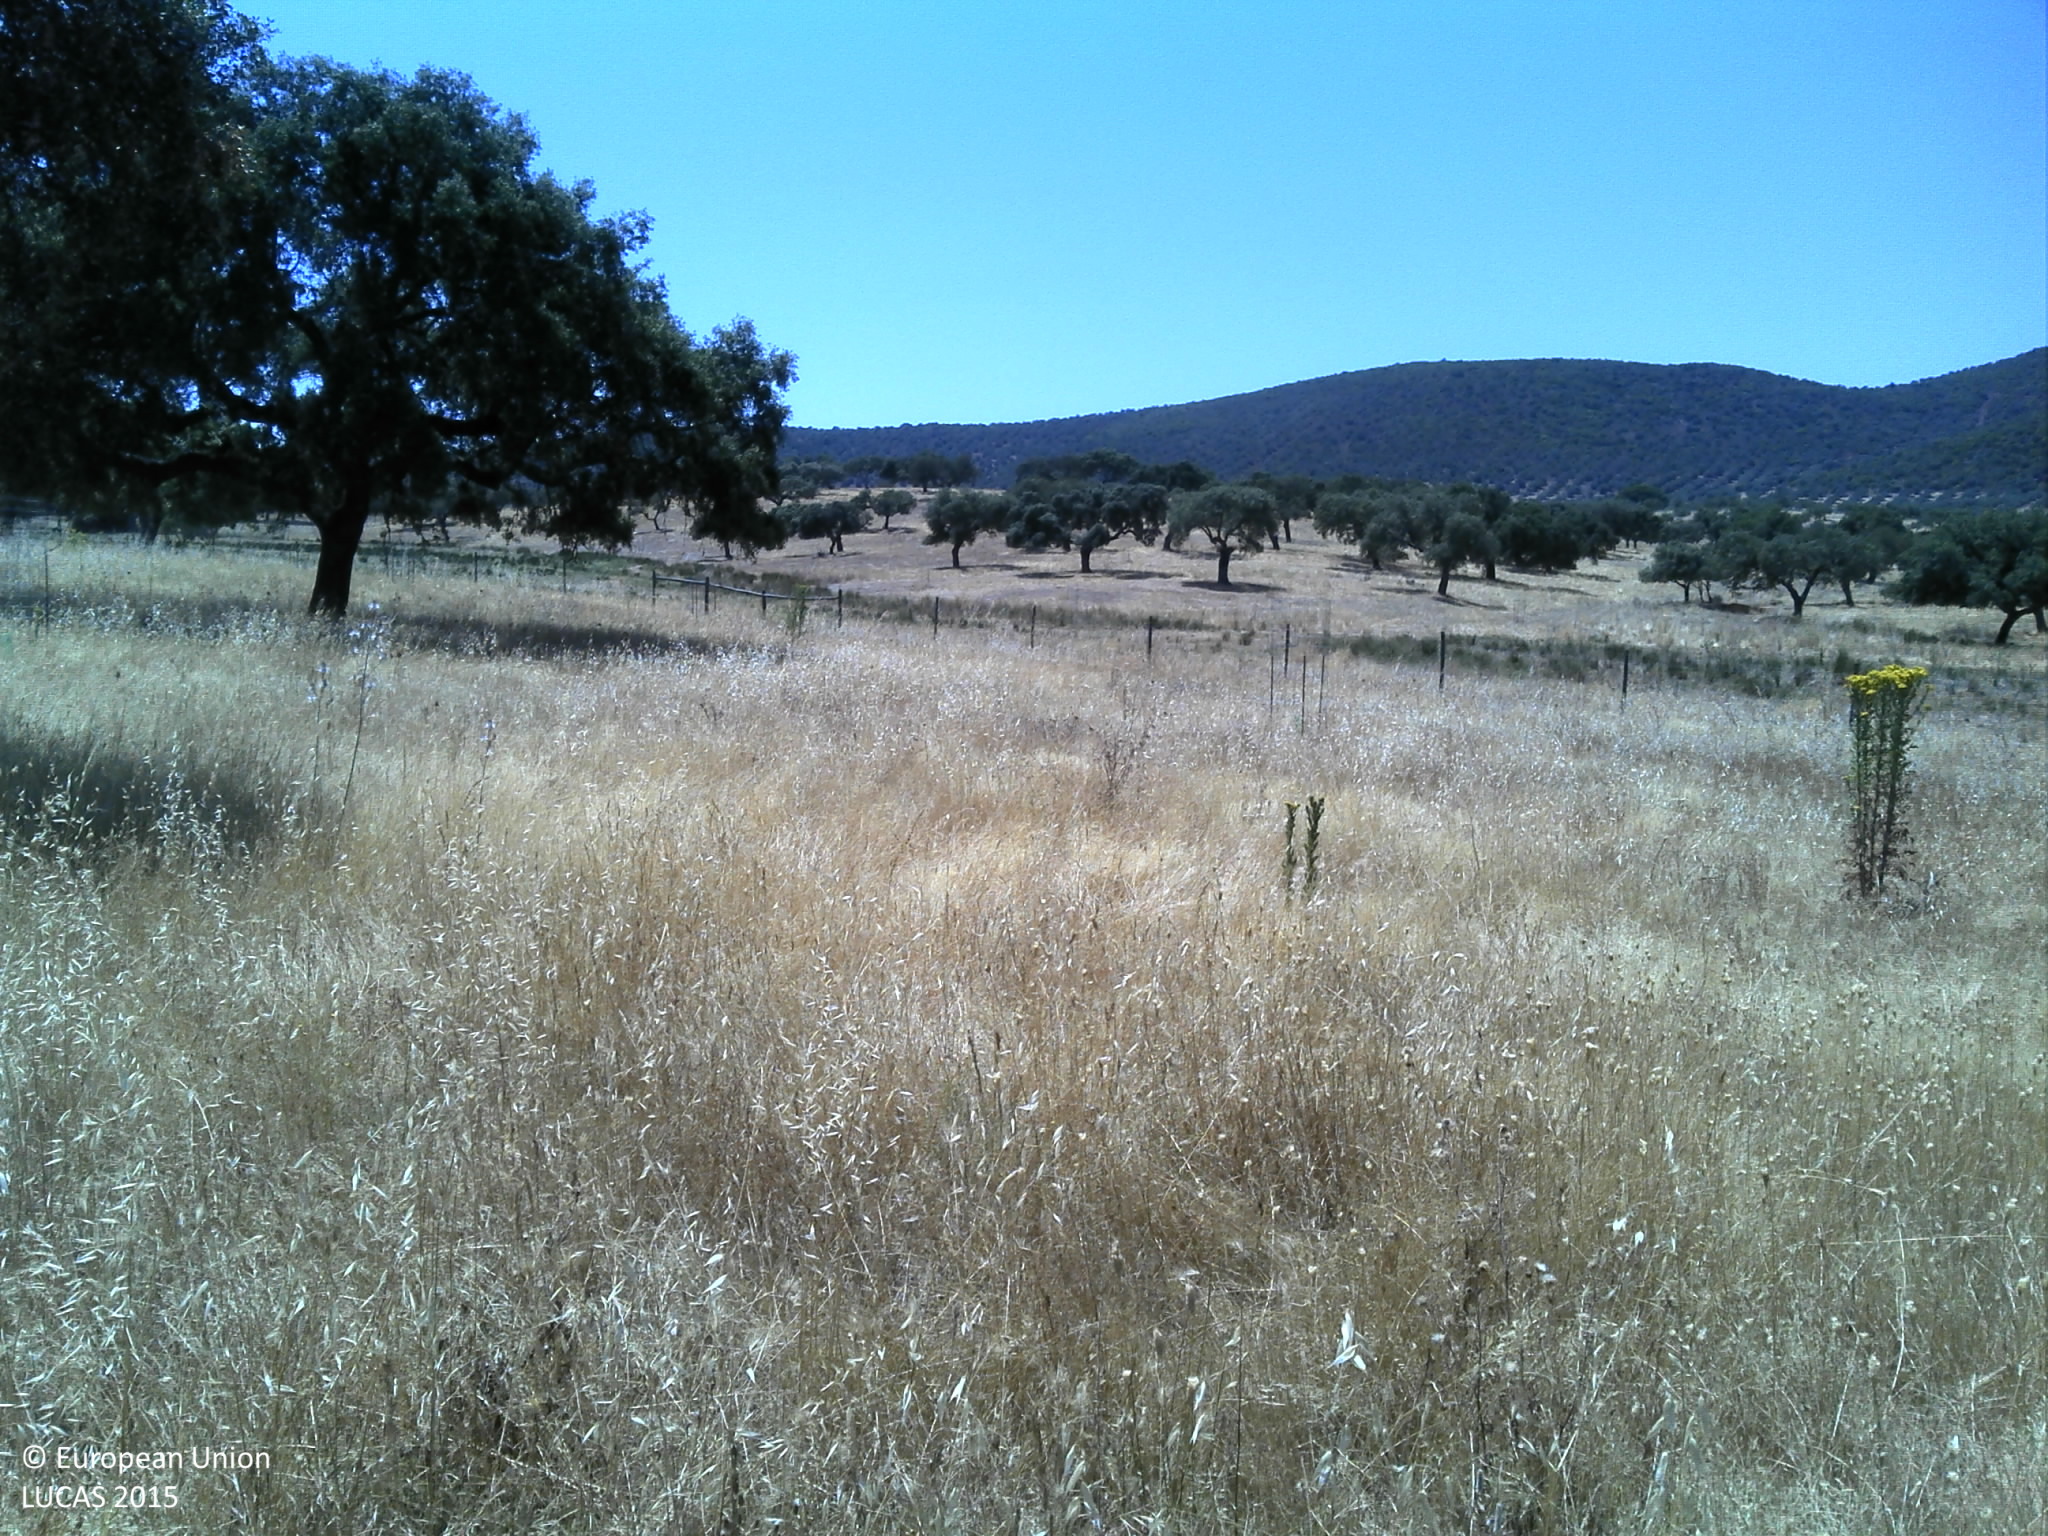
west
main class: Woodland
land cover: Broadleaved woodland
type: broadleaved evergreen forest
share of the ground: 25 - 50 %
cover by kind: herbaceous plants 70 %, broadleaved forest trees 30 %
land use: Forestry
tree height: > 5 m
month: June
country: PT
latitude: 37.9990
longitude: -7.2898
